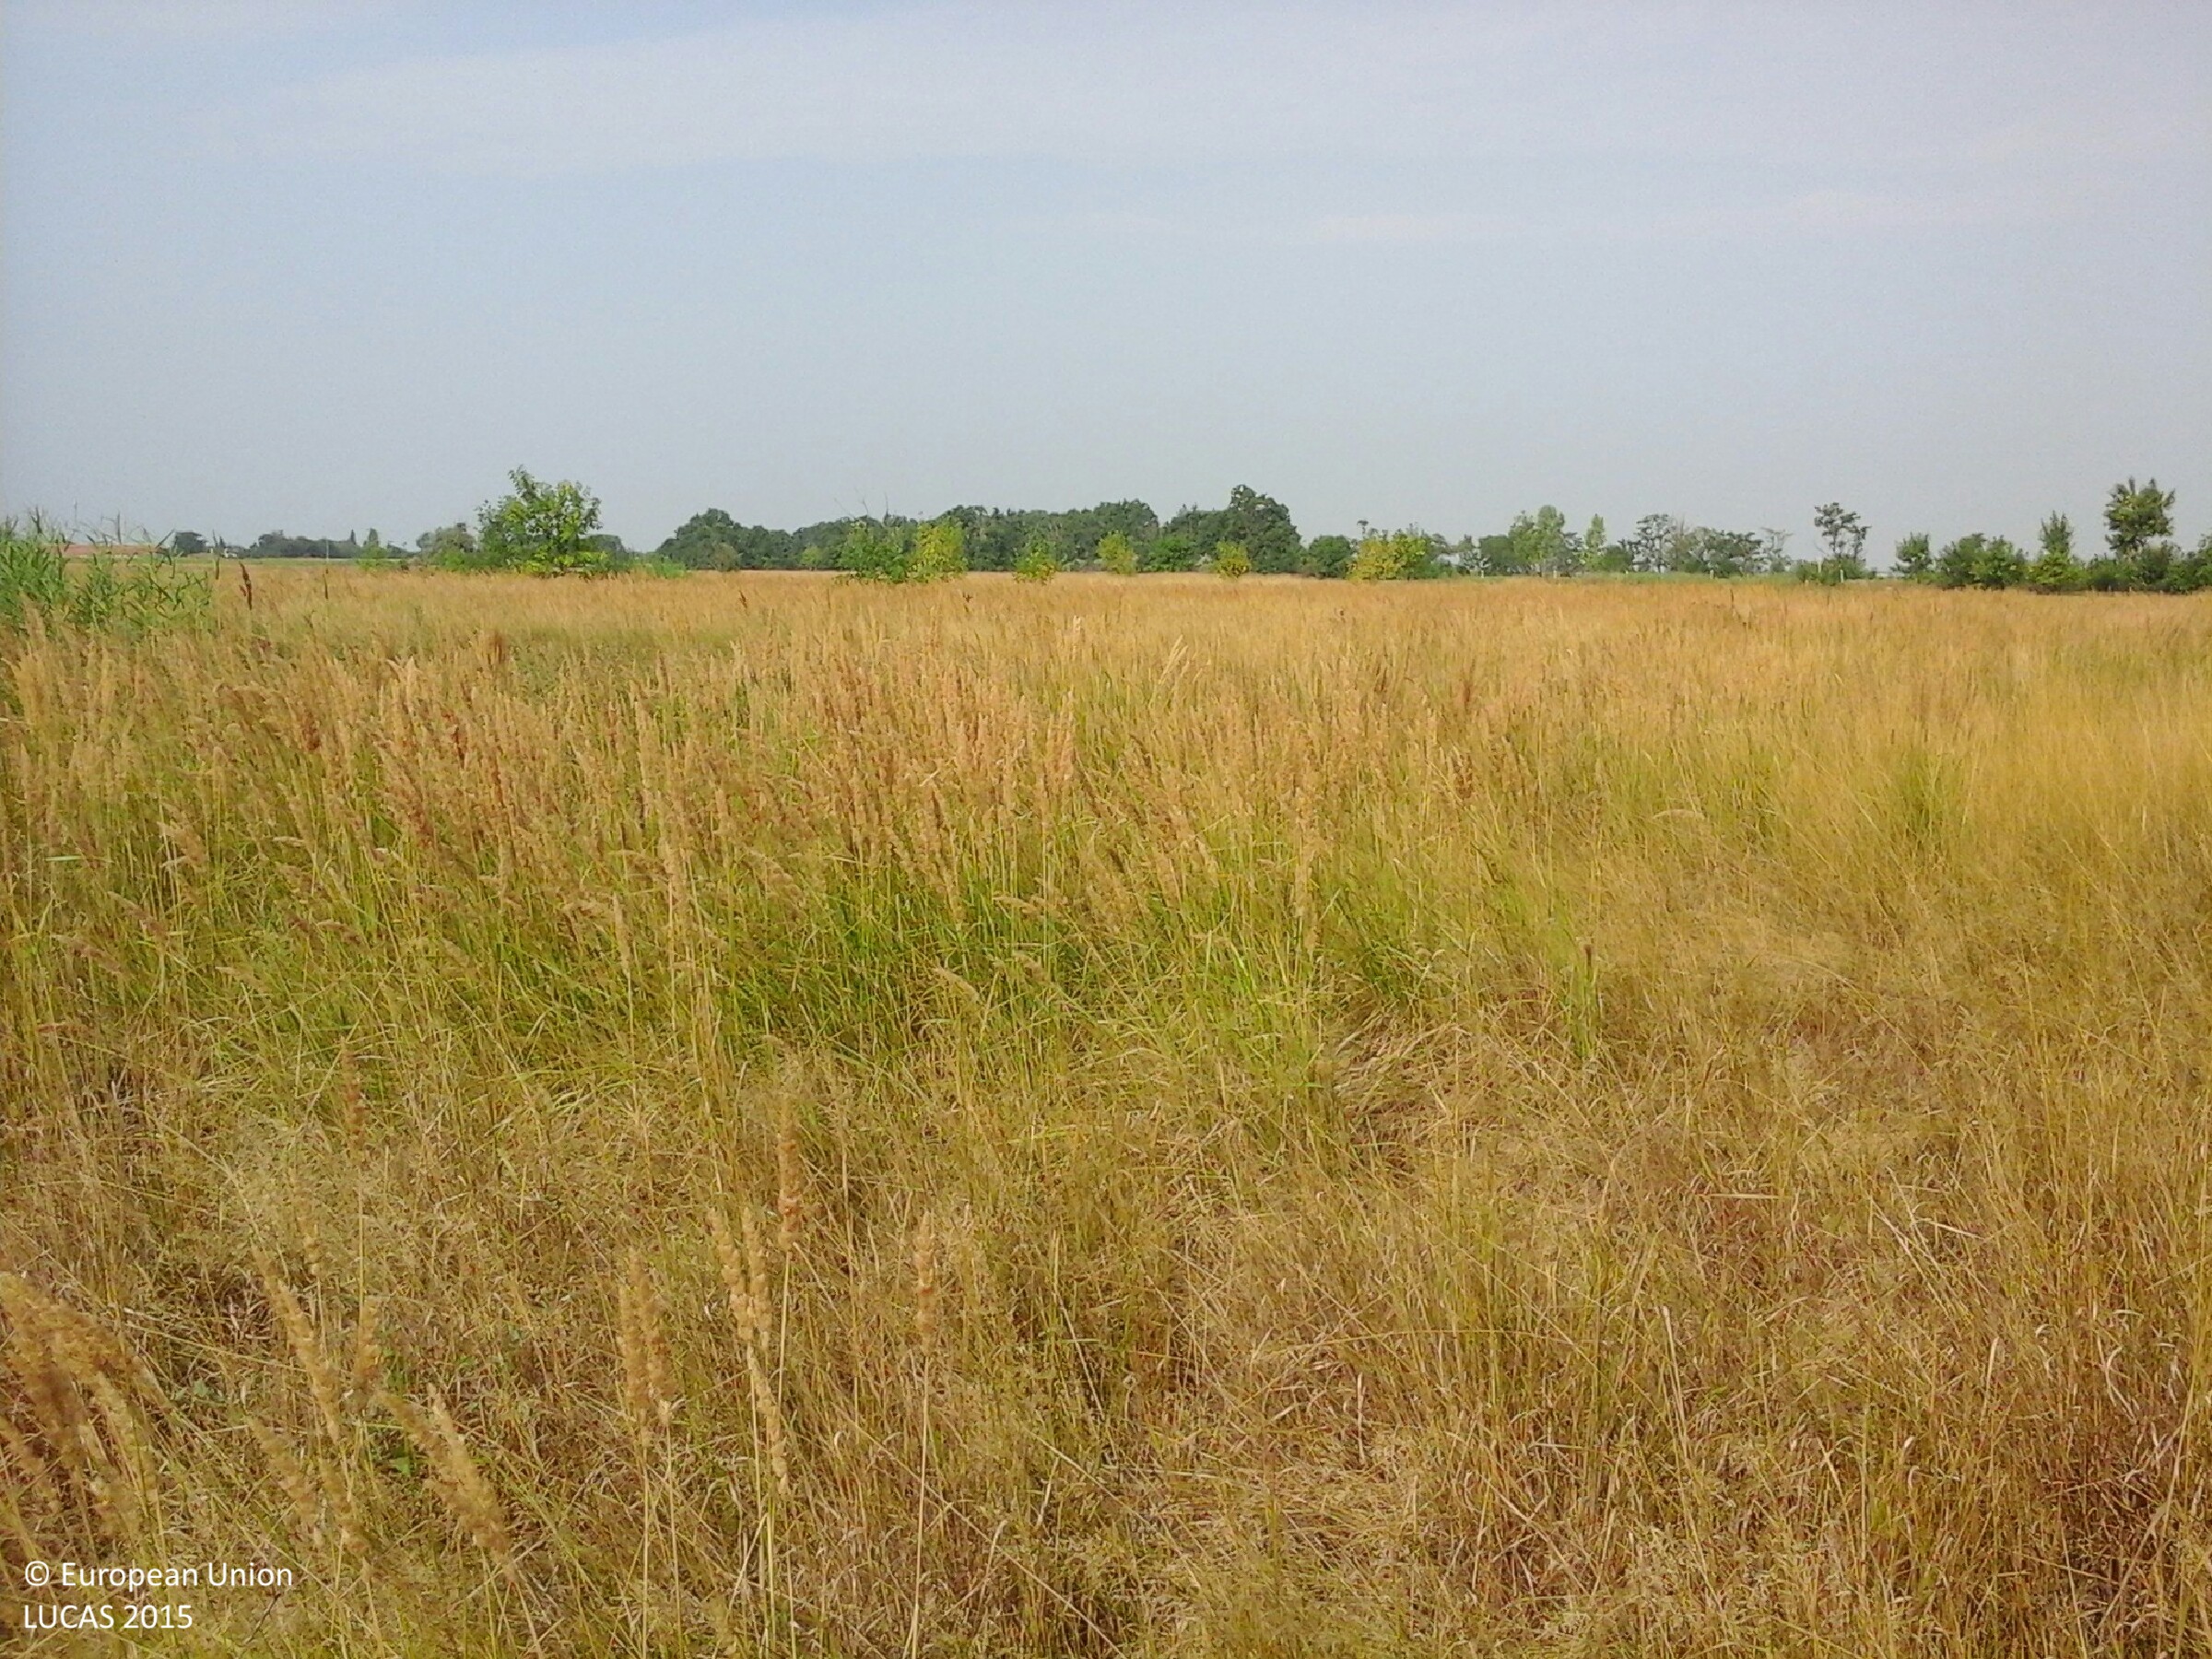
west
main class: Grassland
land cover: Grassland without tree/shrub cover
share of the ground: > 75 %
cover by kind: herbaceous plants 100 %
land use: Agriculture (excluding fallow land and kitchen gardens)
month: August
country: HU
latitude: 47.5497
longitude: 20.9454
